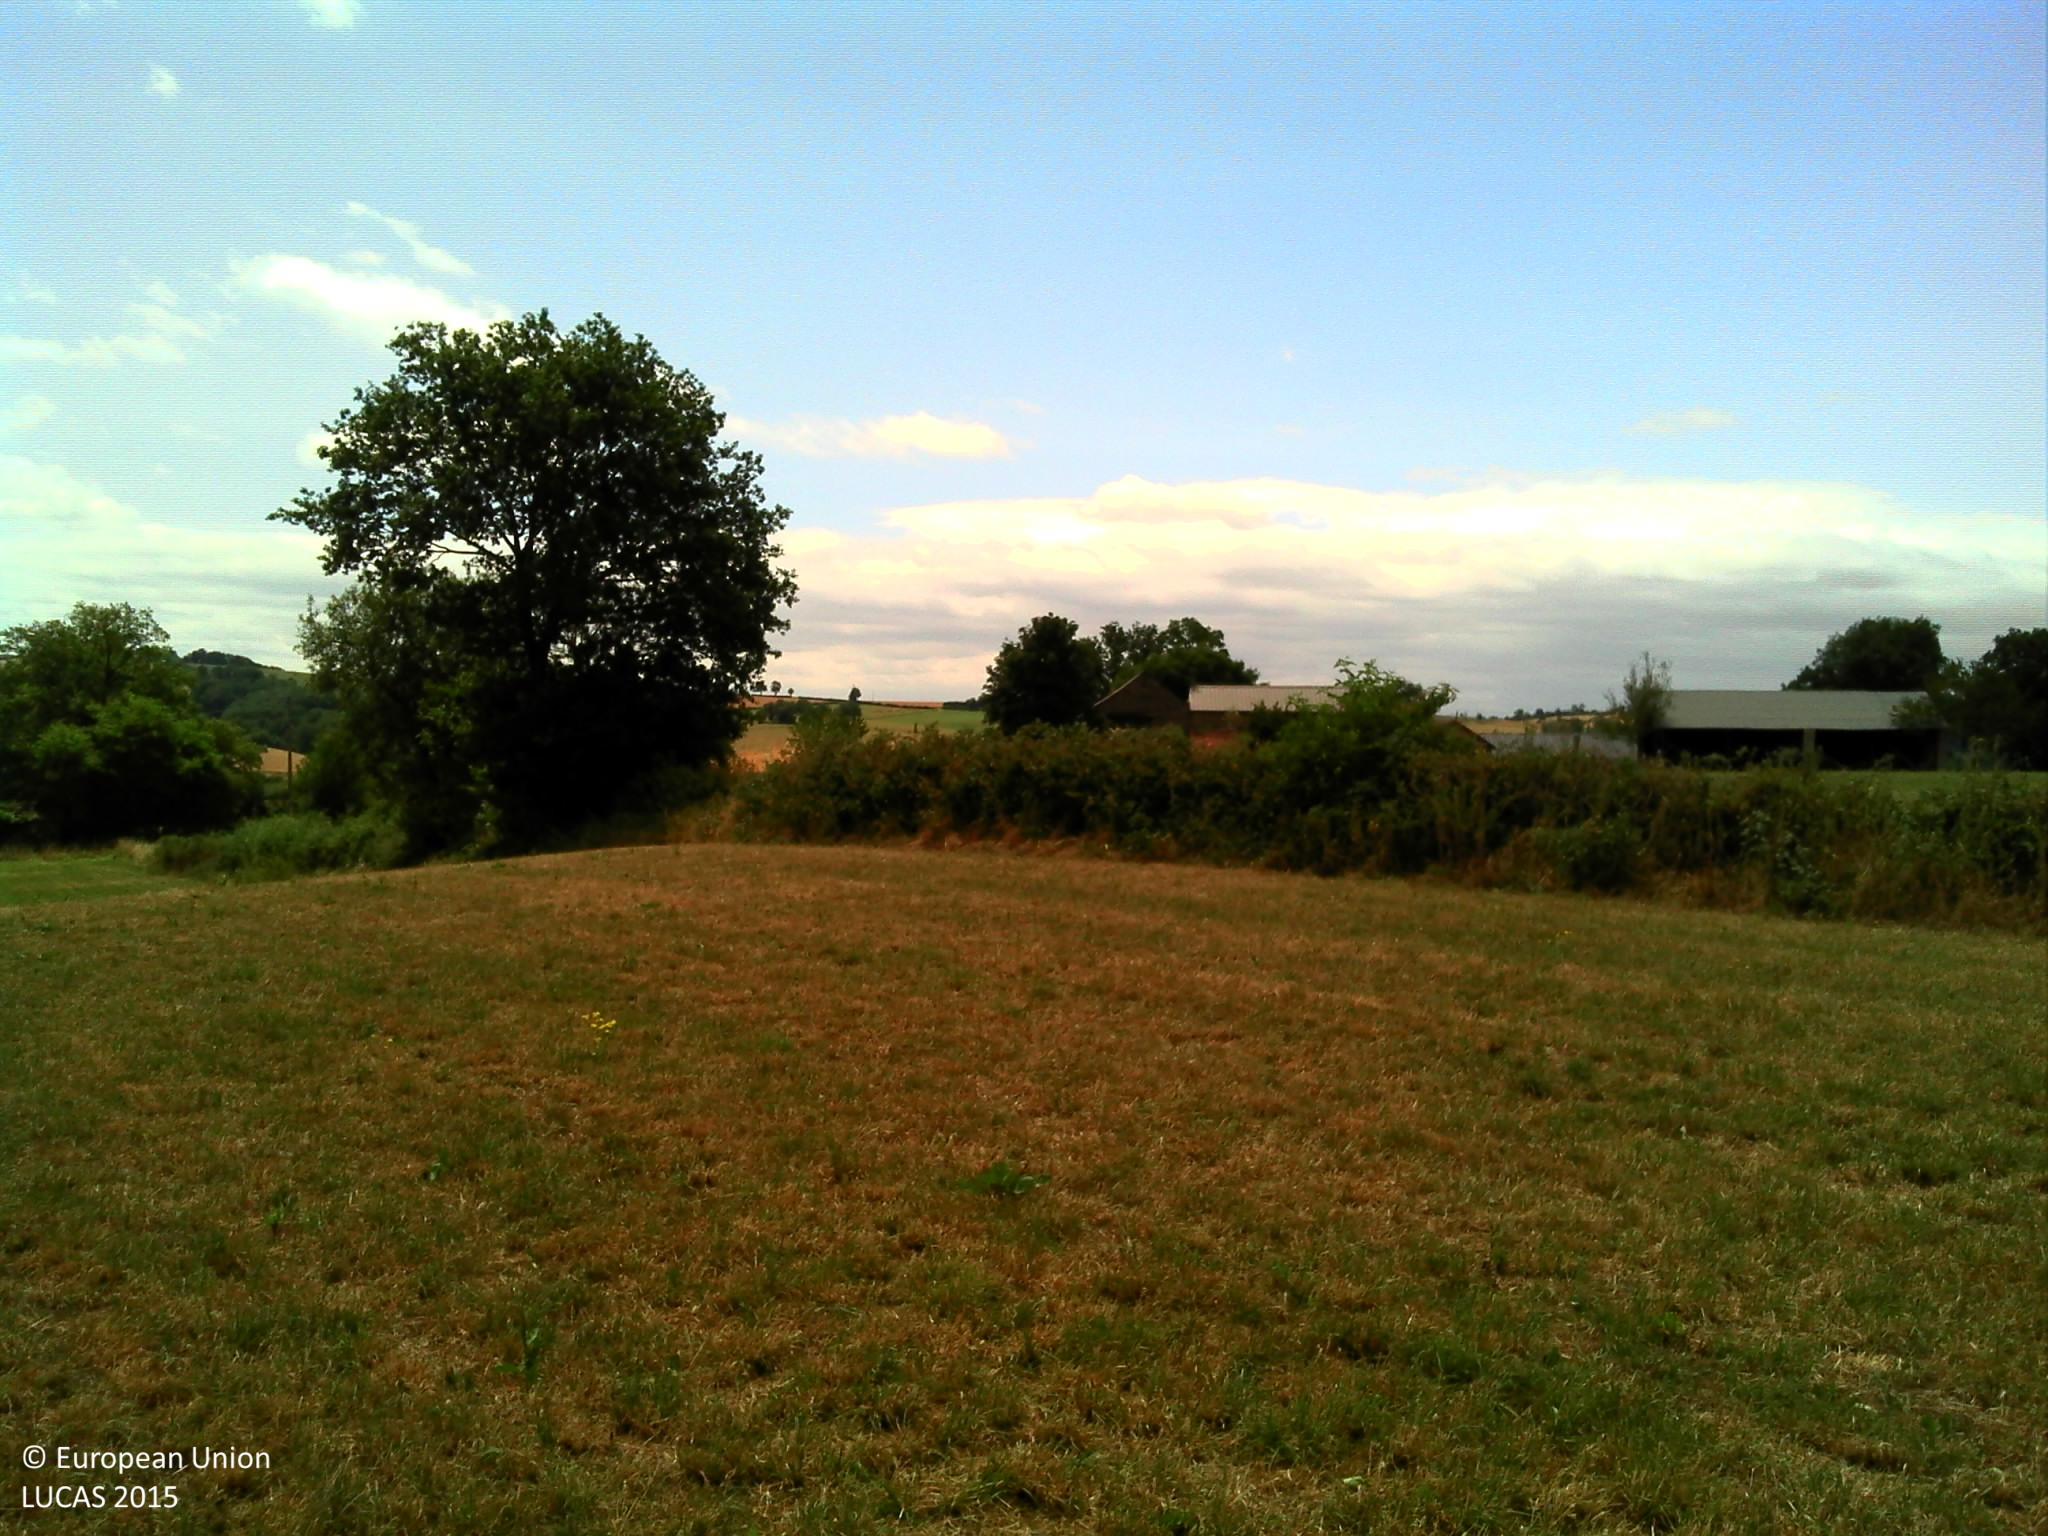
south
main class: Cropland
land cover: Temporary grasslands
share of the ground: > 75 %
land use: Agriculture (excluding fallow land and kitchen gardens)
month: July
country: FR
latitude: 44.1165
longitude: 2.5195
